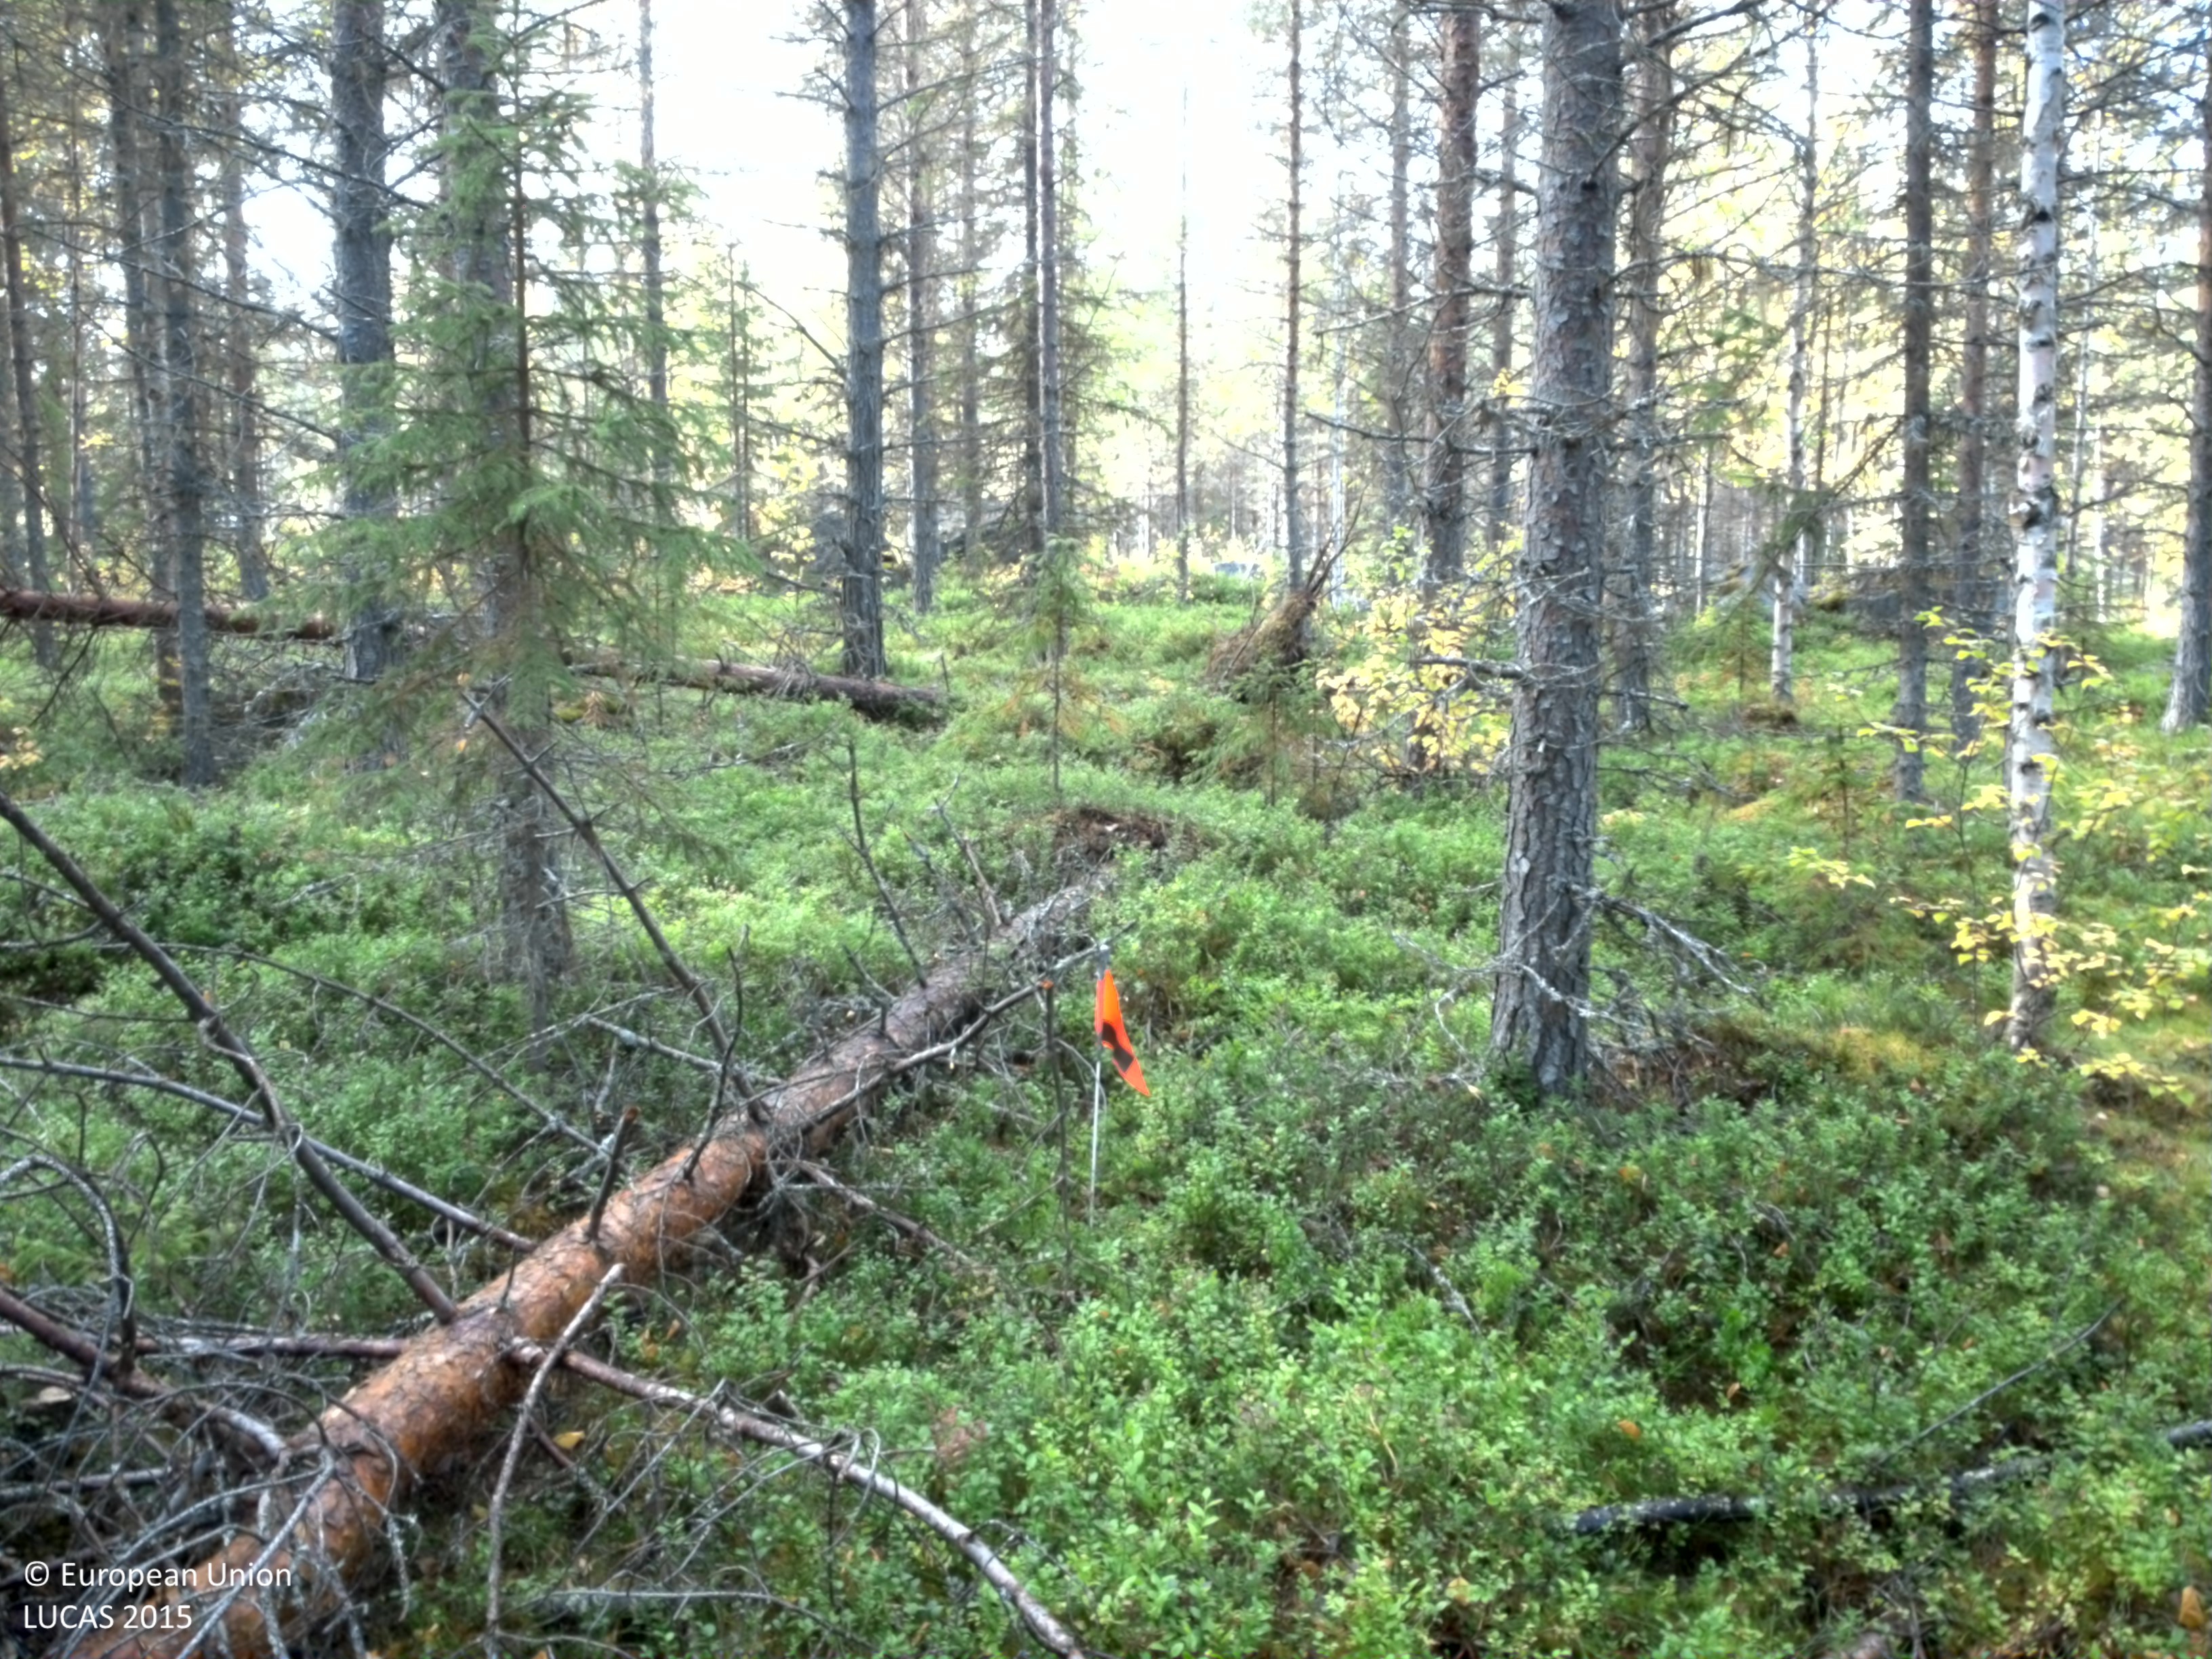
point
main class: Woodland
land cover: Pine dominated coniferous woodland
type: boreal forest
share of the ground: 25 - 50 %
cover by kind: shrubs 45 %, coniferous forest trees 30 %, herbaceous plants 10 %, lichens and mosses 10 %, broadleaved forest trees 5 %
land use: Forestry
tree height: > 5 m
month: September
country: SE
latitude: 65.2180
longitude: 16.6979
